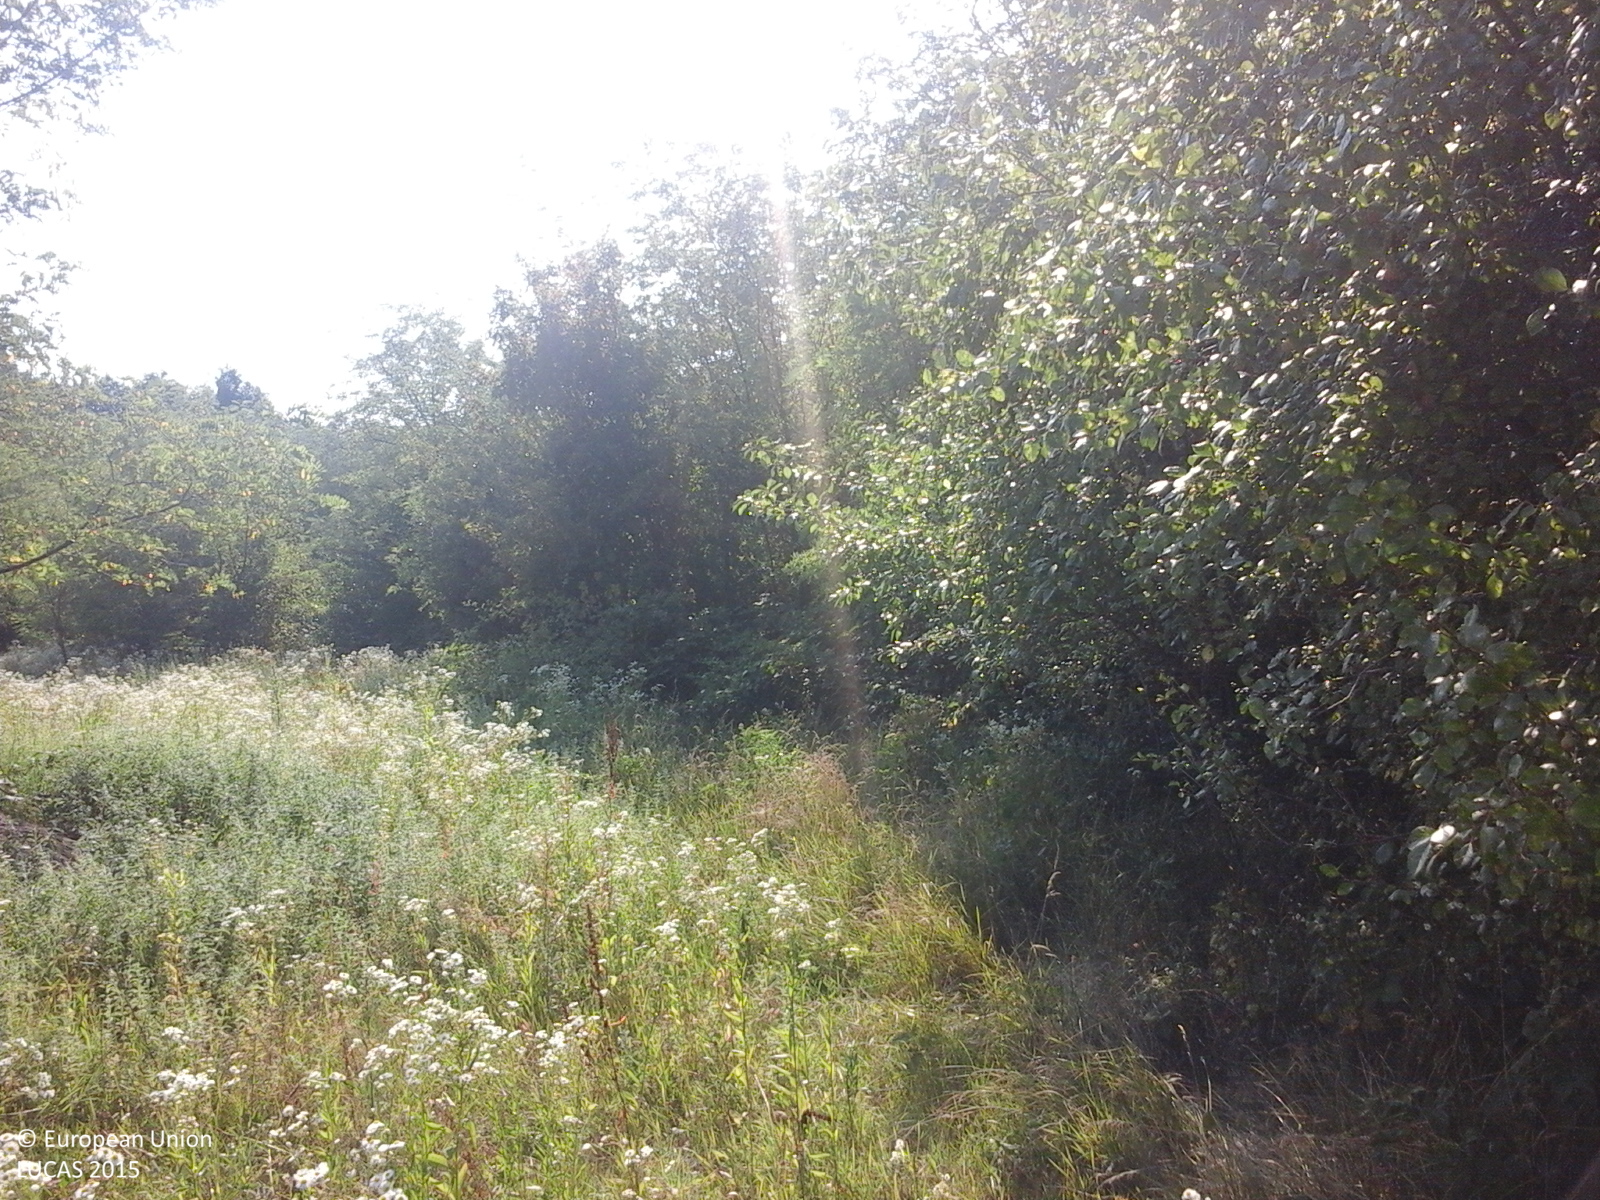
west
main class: Grassland
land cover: Spontaneously vegetated surfaces
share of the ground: > 75 %
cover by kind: herbaceous plants 100 %
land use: Agriculture (excluding fallow land and kitchen gardens)
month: July
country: RO
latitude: 44.7693
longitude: 24.6447
